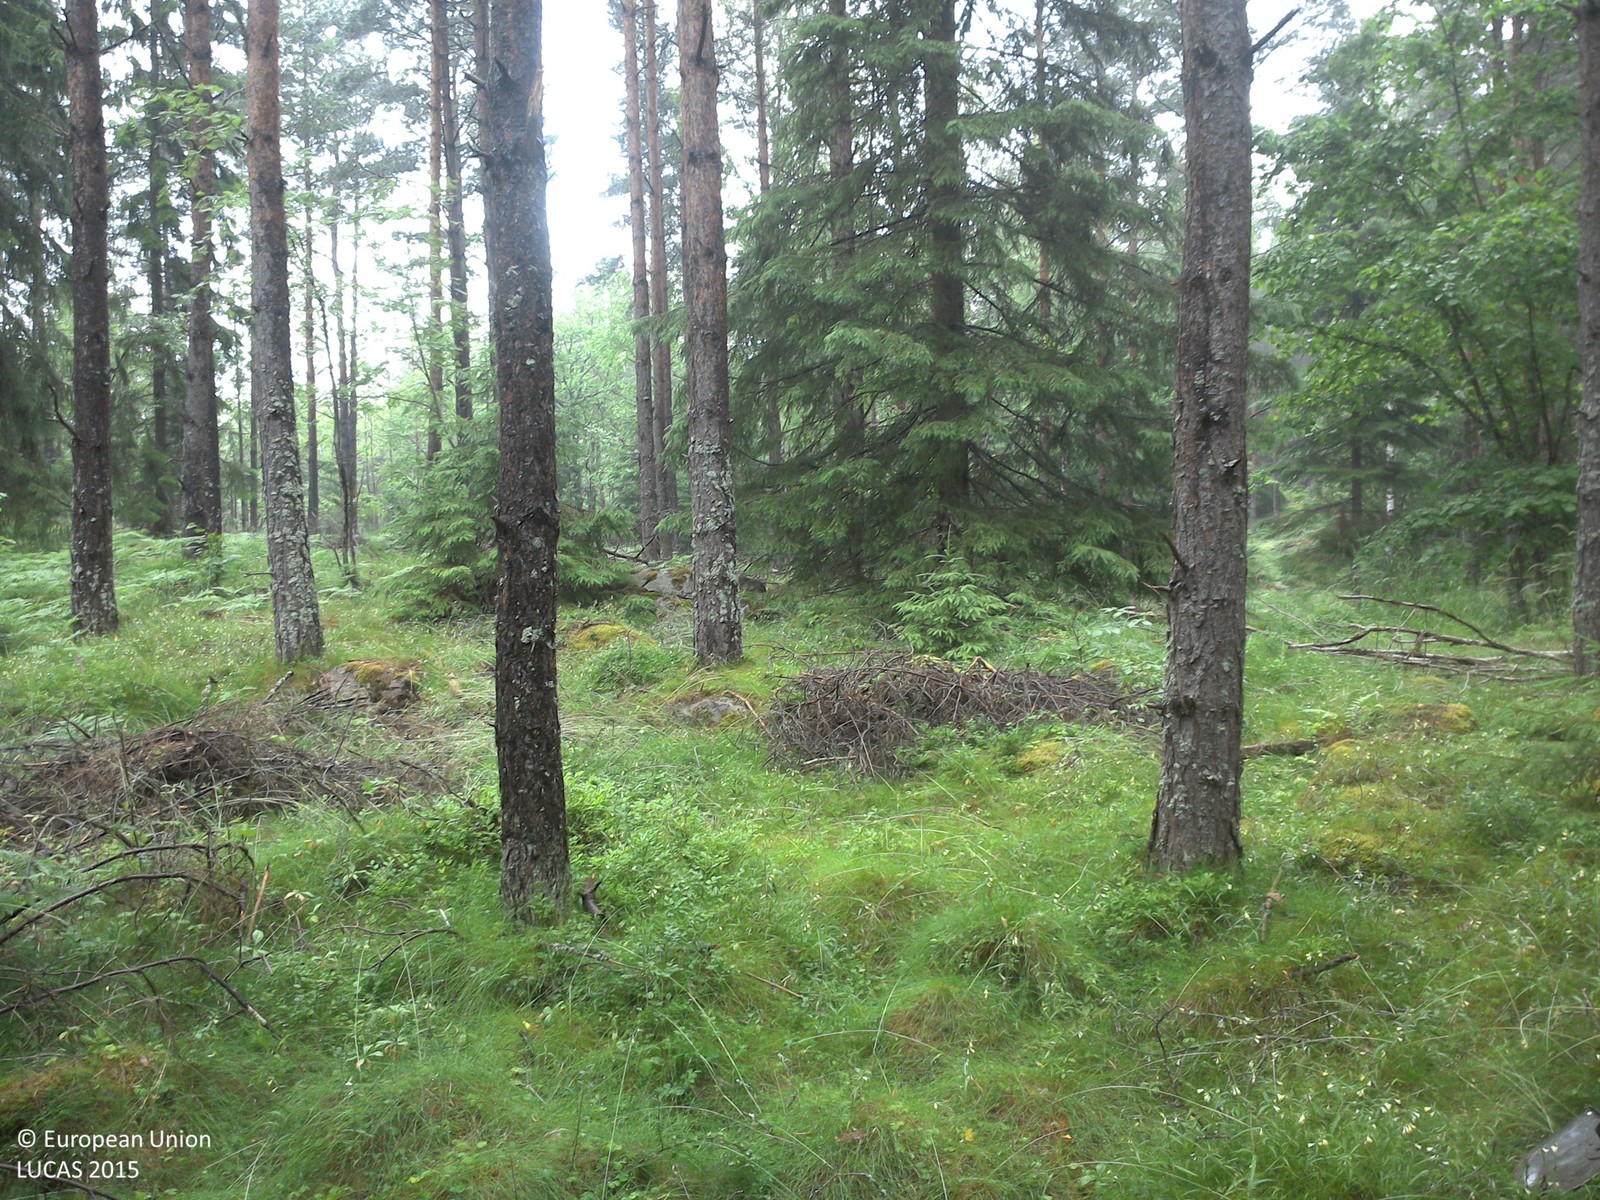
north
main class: Woodland
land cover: Pine dominated coniferous woodland
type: boreal forest
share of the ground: > 75 %
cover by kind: coniferous forest trees 75 %, herbaceous plants 20 %, lichens and mosses 5 %
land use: Forestry
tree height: > 5 m
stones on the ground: < 10 %
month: July
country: SE
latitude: 58.5940
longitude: 15.0346
